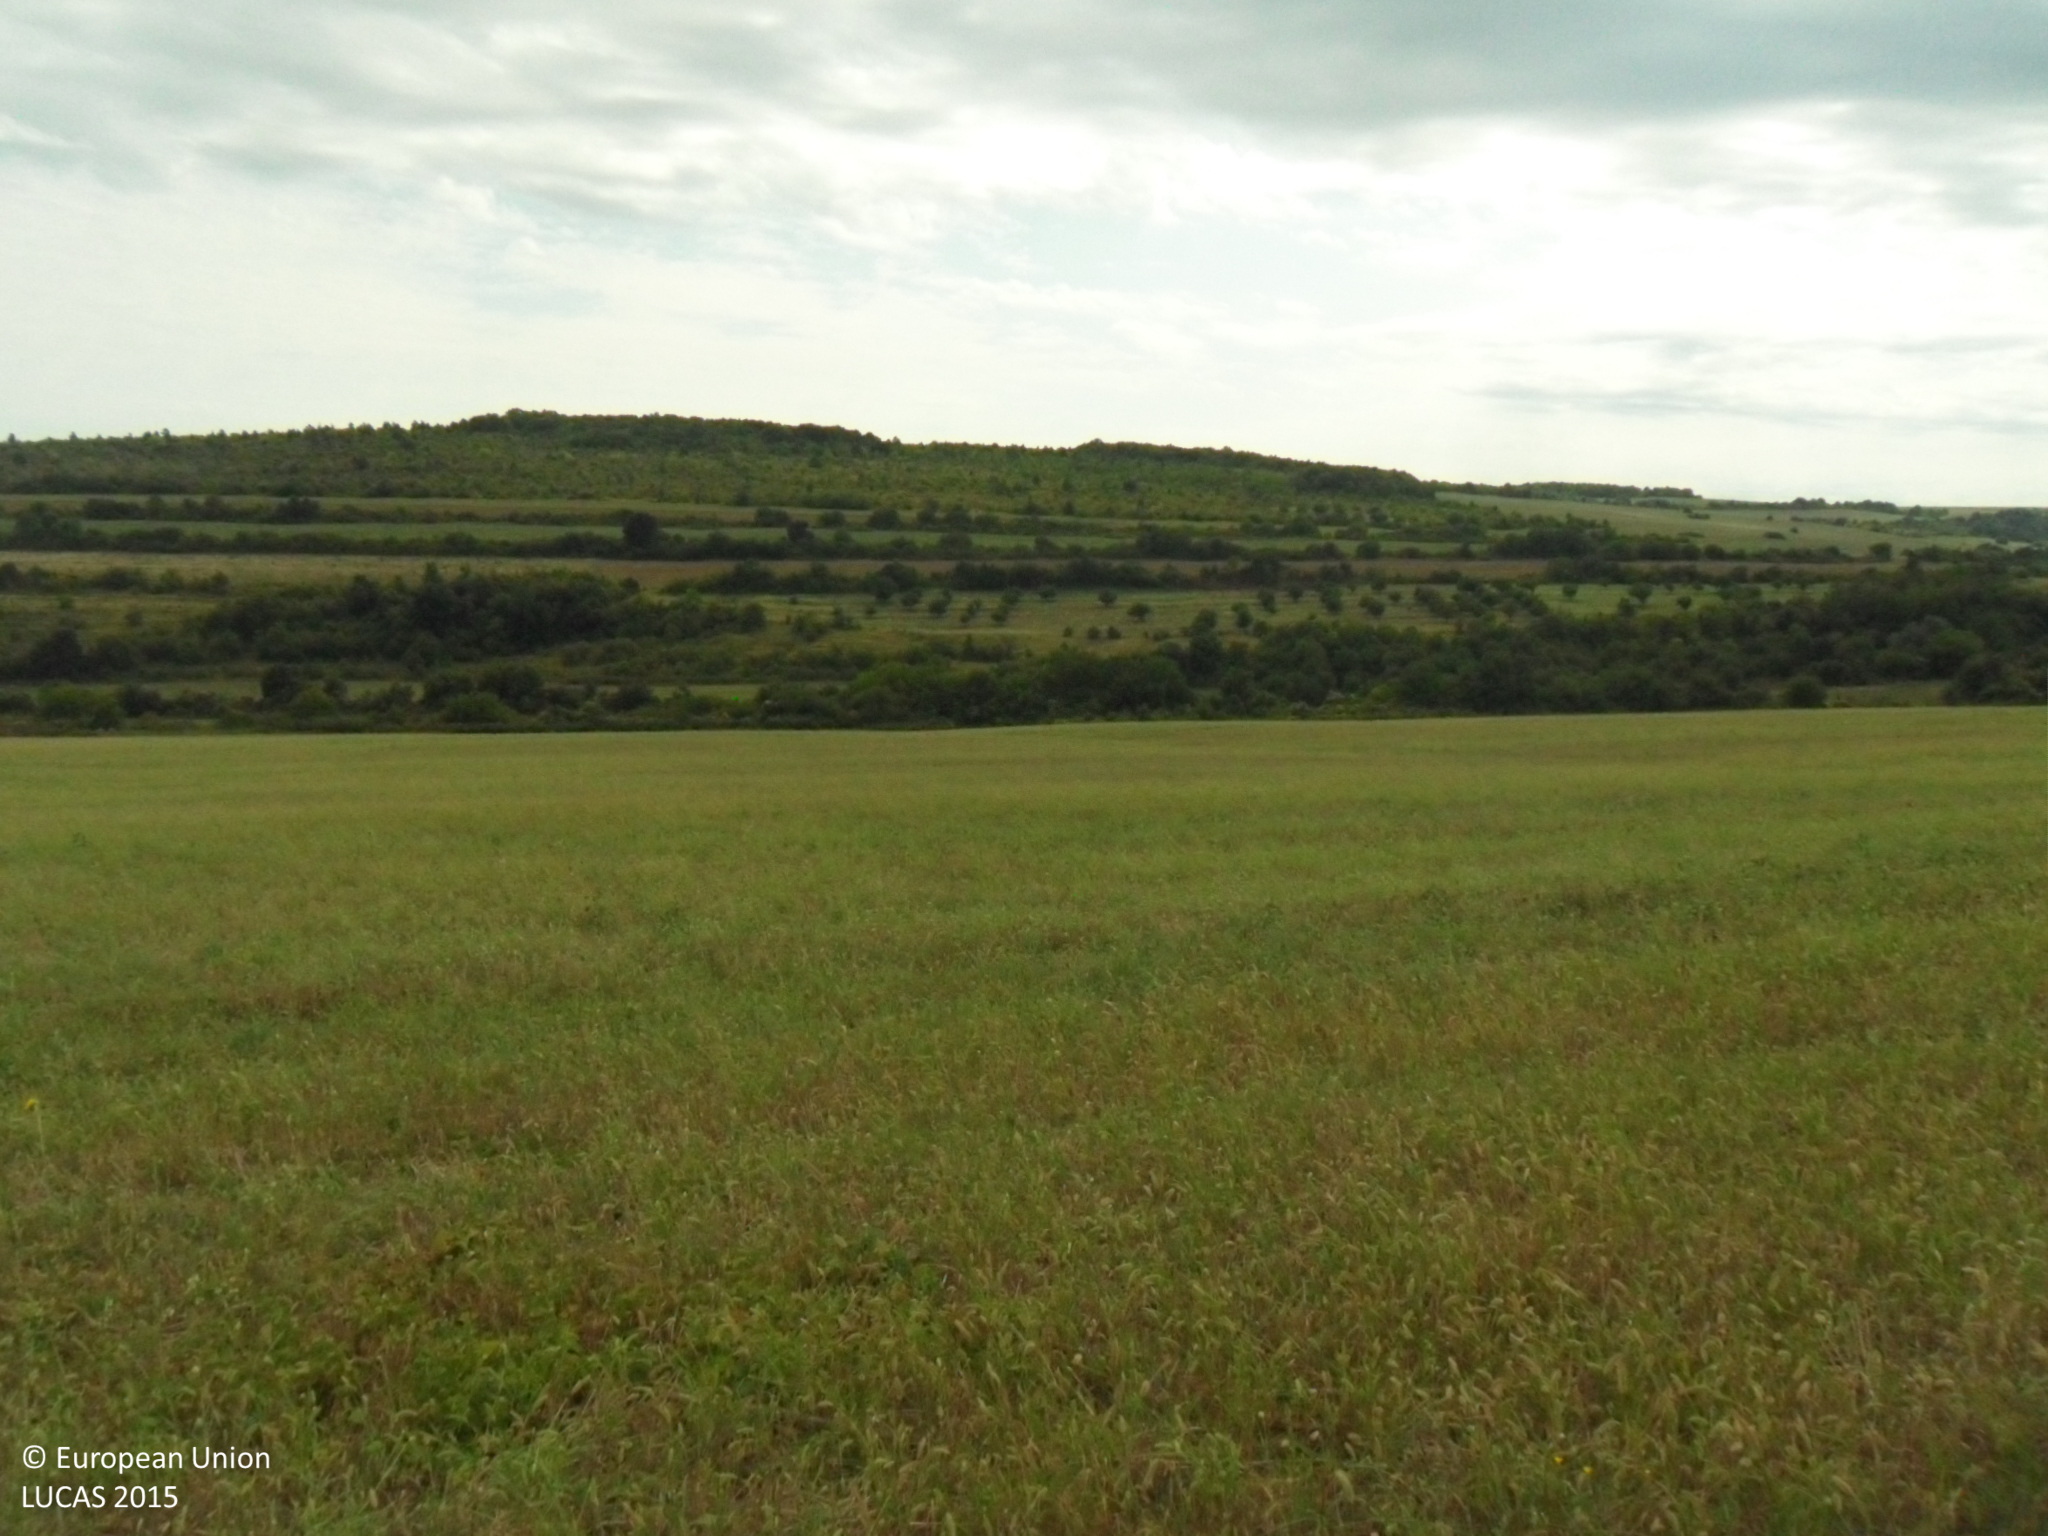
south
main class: Cropland
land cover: Common wheat
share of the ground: > 75 %
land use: Agriculture (excluding fallow land and kitchen gardens)
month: September
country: BG
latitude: 43.5567
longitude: 26.3555
